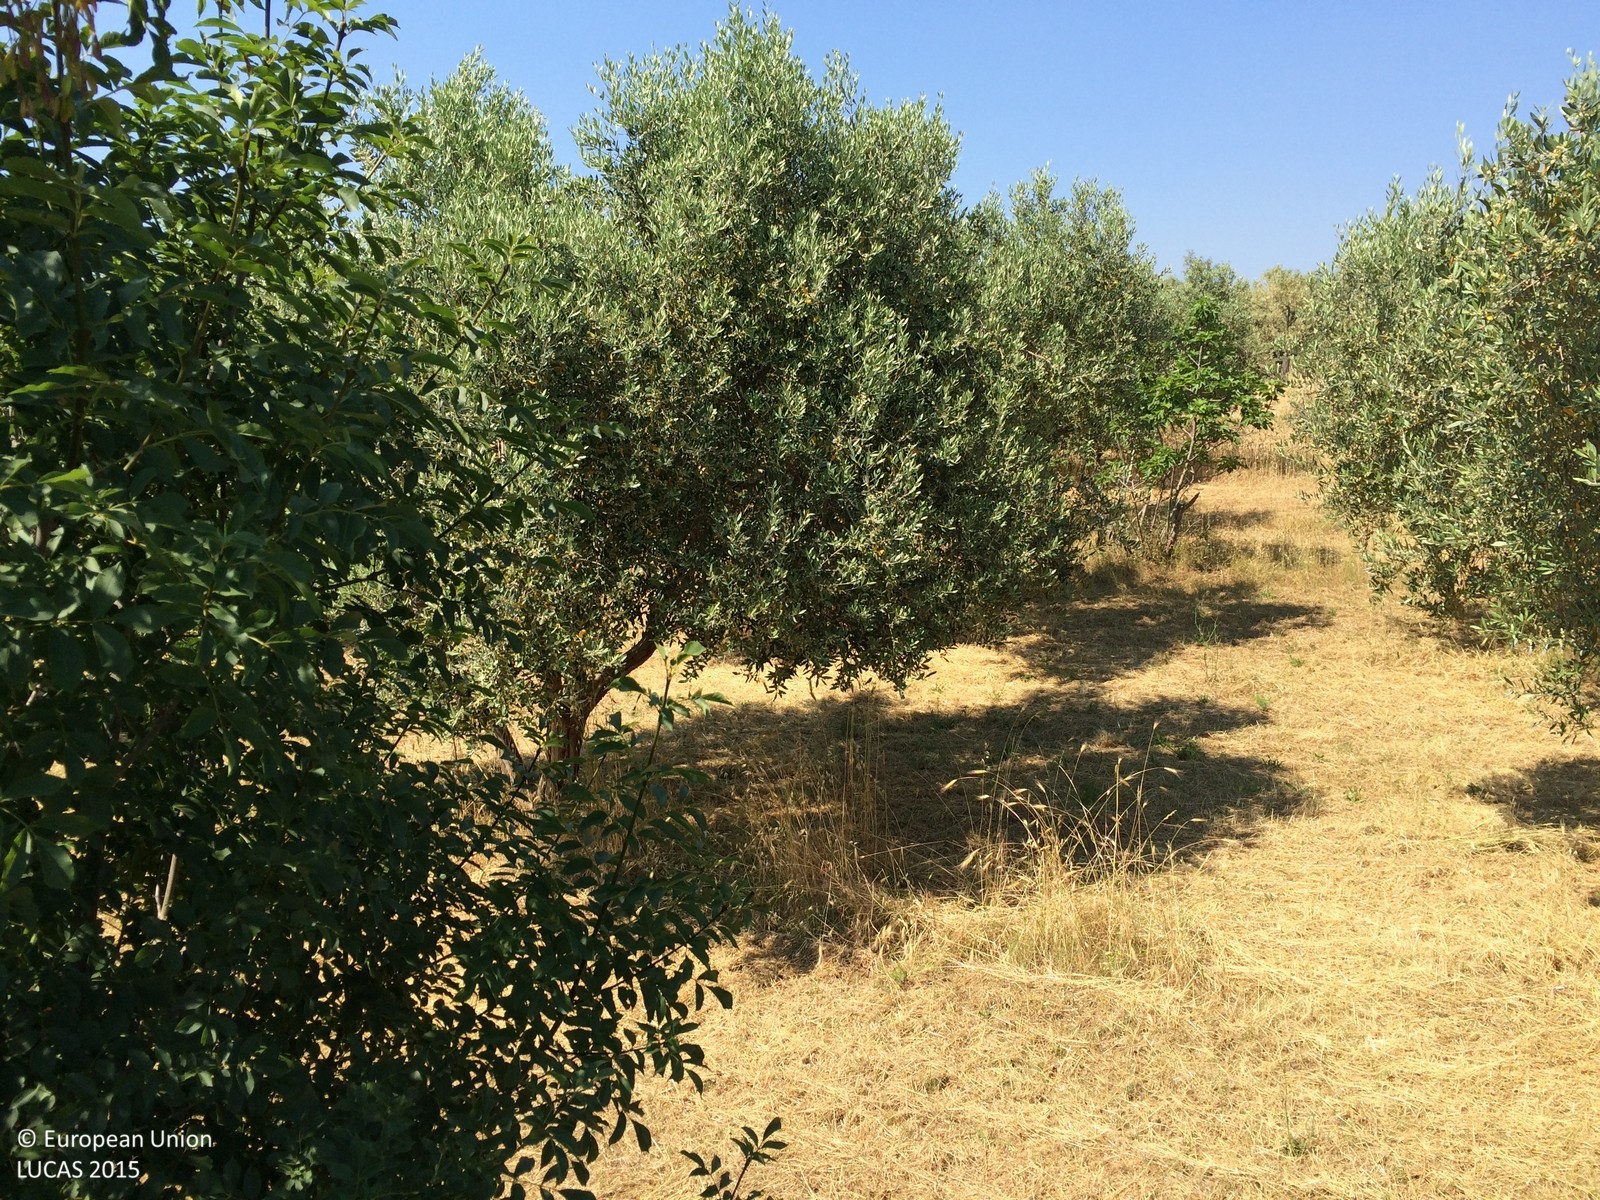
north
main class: Shrubland
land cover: Shrubland with sparse tree cover
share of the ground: > 75 %
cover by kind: shrubs 90 %, broadleaved forest trees 5 %, herbaceous plants 5 %
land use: Semi-natural and natural areas not in use
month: June
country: HR
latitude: 44.9836
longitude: 13.8370
